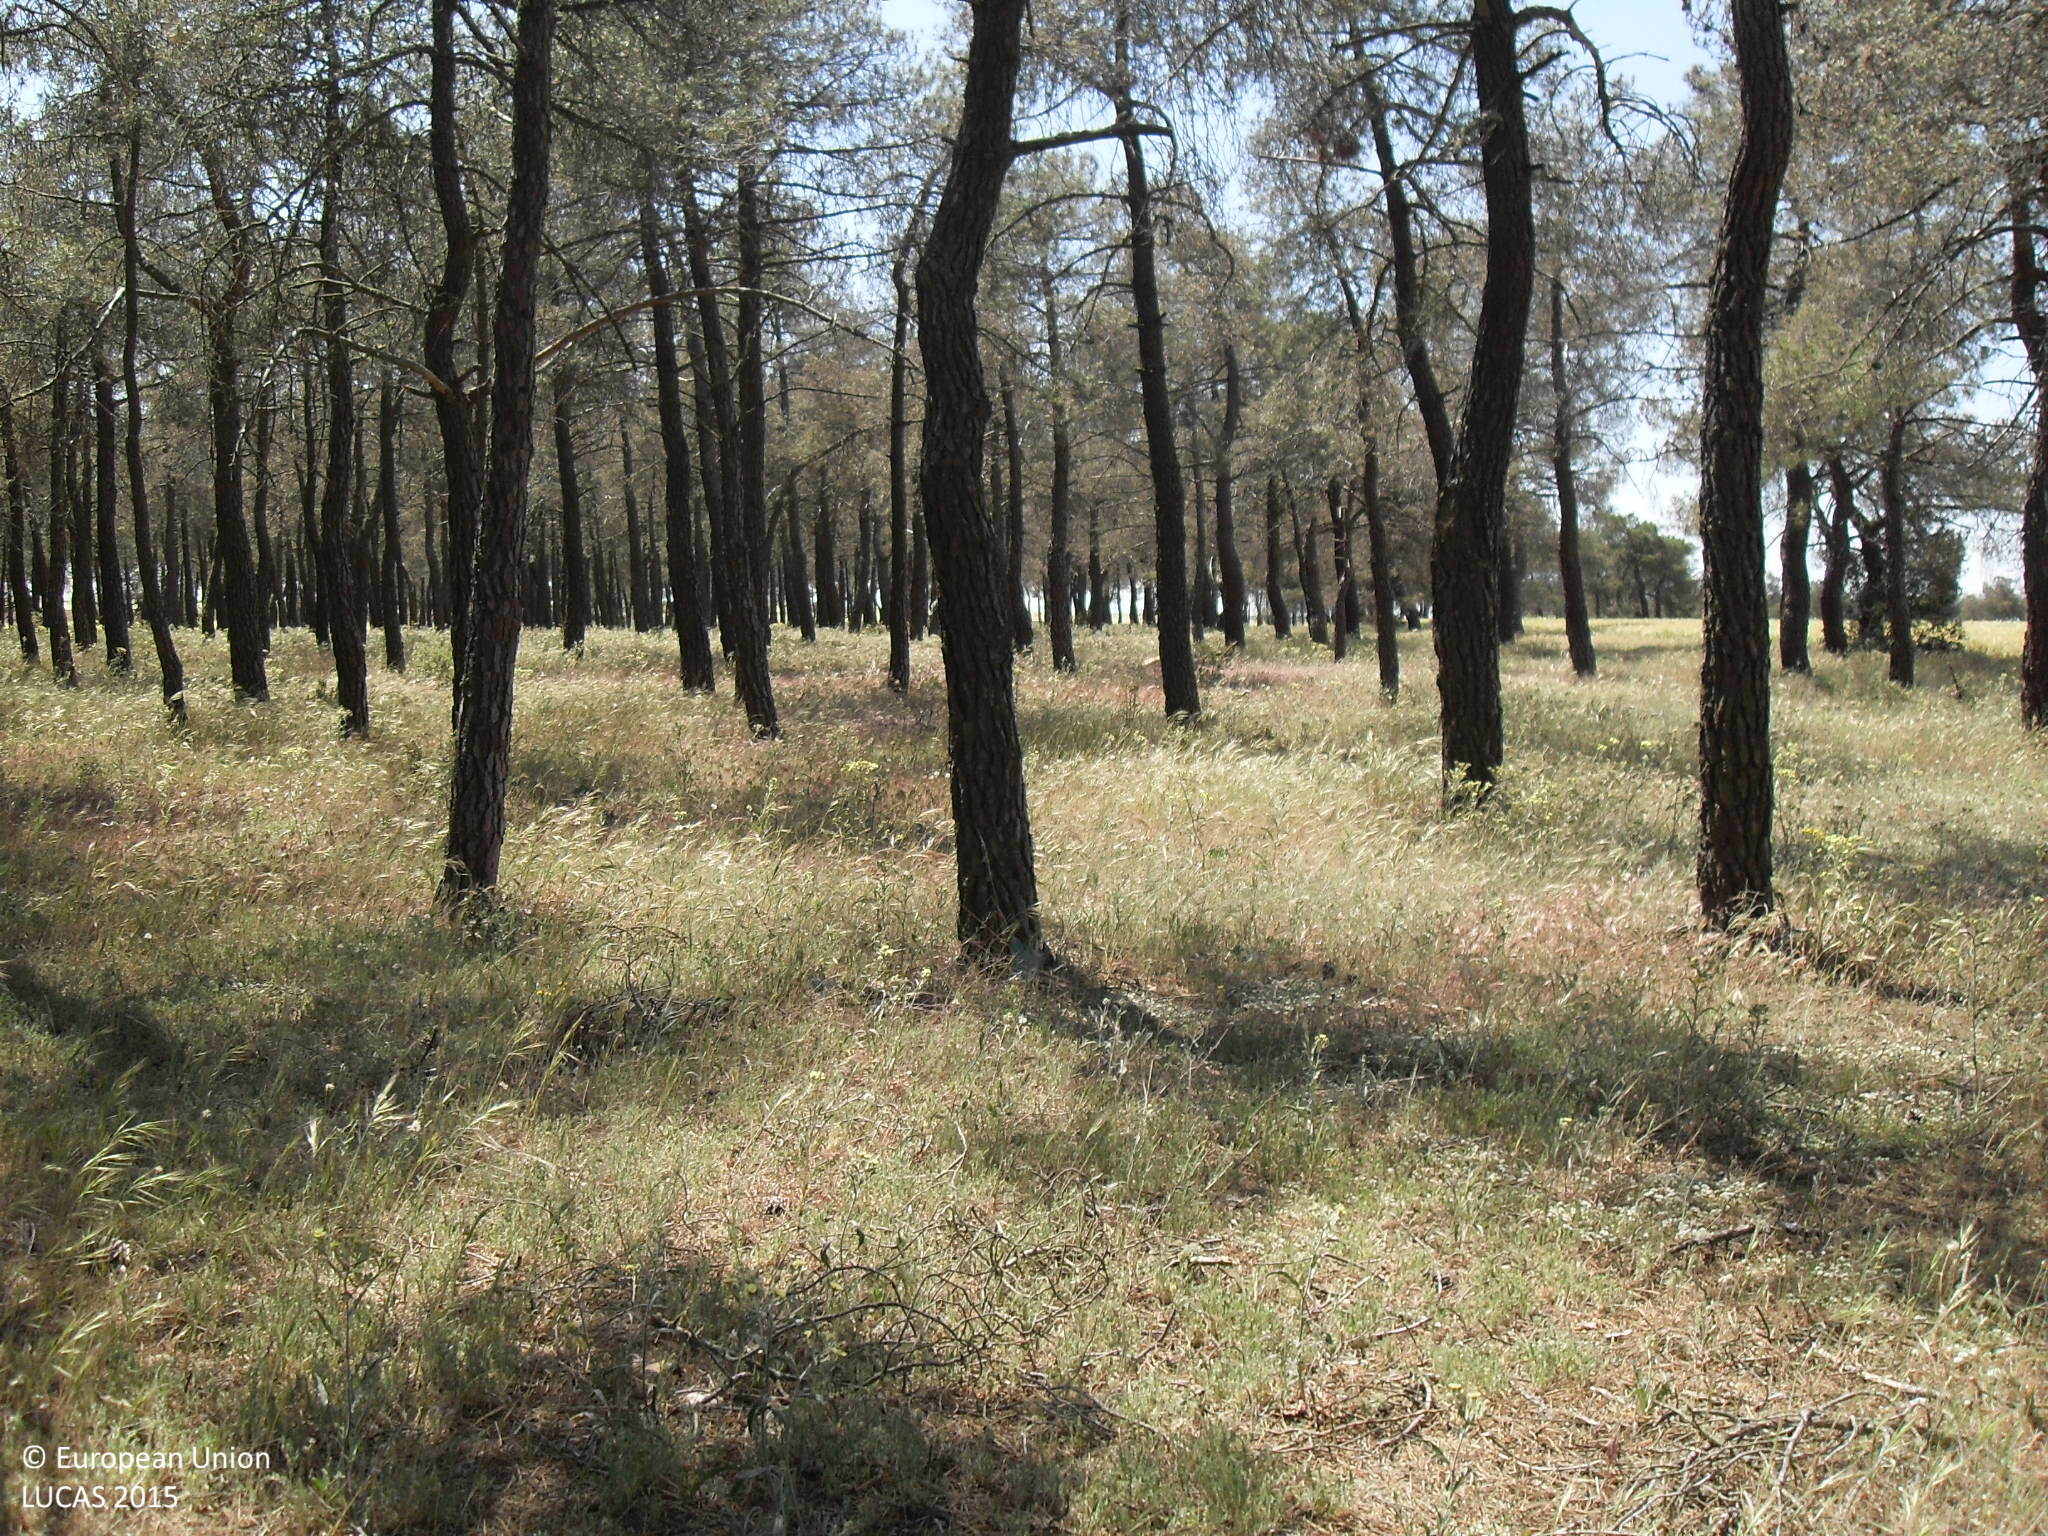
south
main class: Woodland
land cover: Pine dominated coniferous woodland
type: coniferous forest of the mediterranean region
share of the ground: > 75 %
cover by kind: coniferous forest trees 100 %
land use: Forestry
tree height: > 5 m
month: May
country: ES
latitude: 41.1166
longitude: -5.0621
